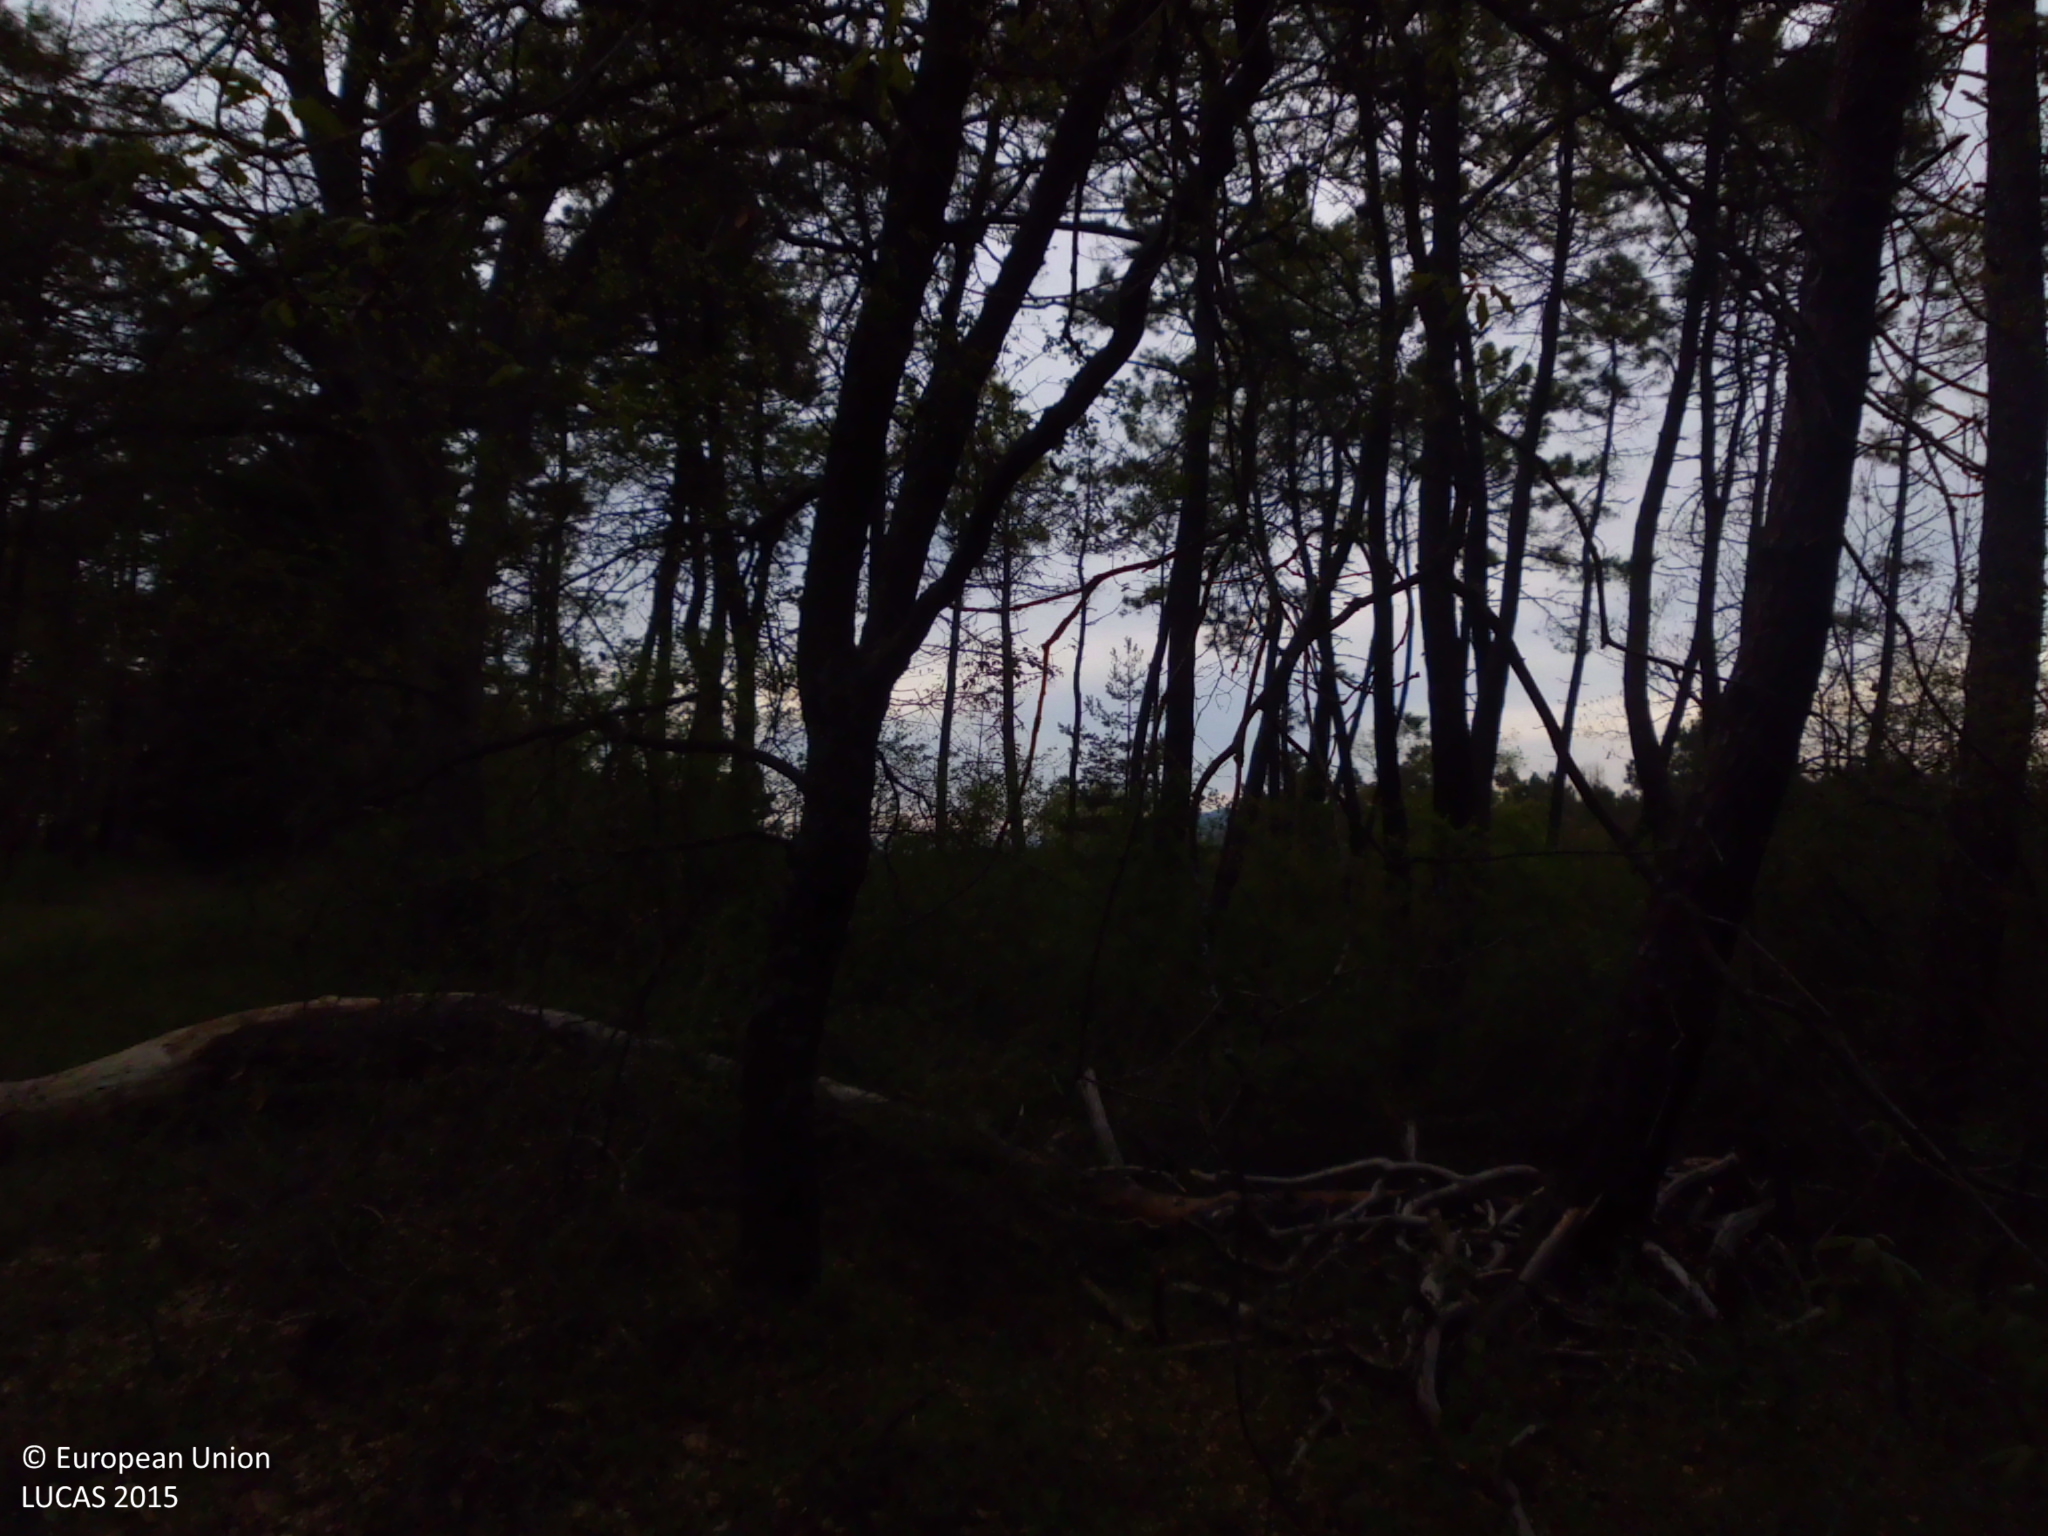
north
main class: Woodland
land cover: Pine dominated mixed woodland
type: coniferous forest of the mediterranean region
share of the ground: > 75 %
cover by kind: coniferous forest trees 50 %, broadleaved forest trees 25 %, shrubs 15 %, herbaceous plants 10 %
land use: Semi-natural and natural areas not in use
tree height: > 5 m
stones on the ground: < 10 %
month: April
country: ES
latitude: 42.8041
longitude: -3.3768
